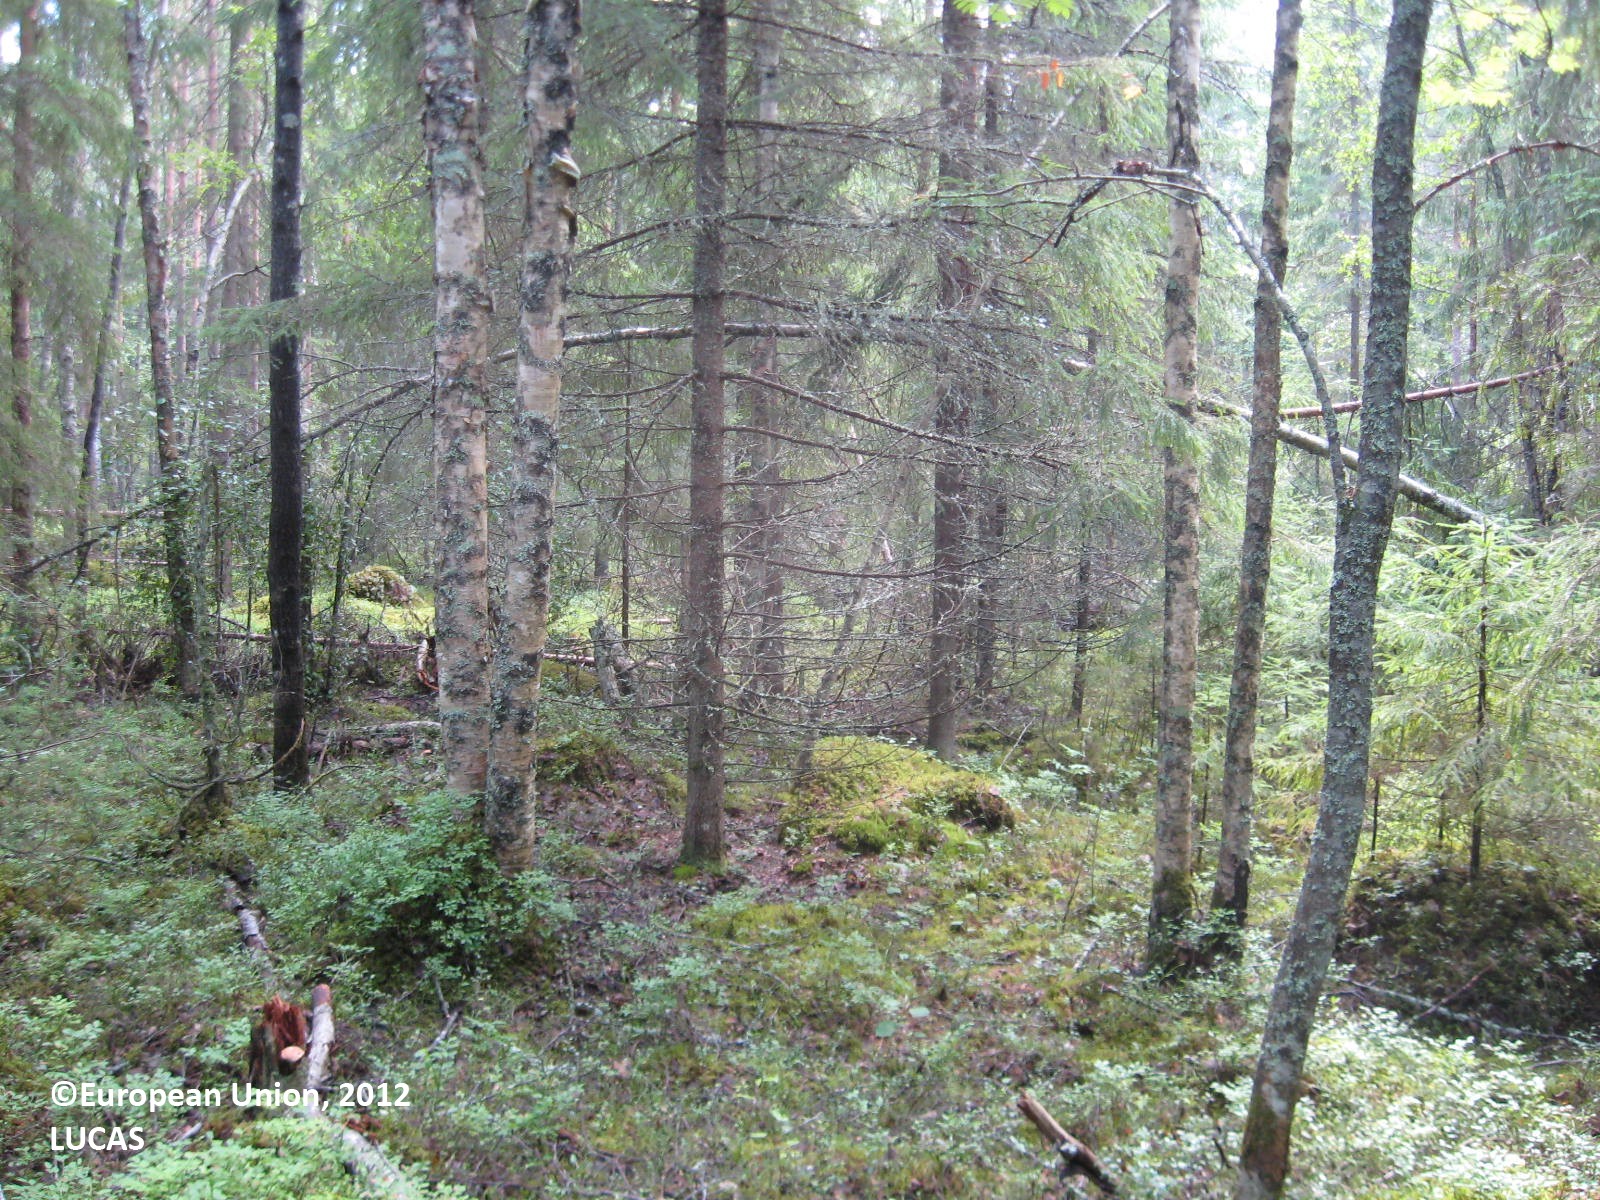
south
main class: Woodland
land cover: Other mixed woodland
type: boreal forest
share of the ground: > 75 %
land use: Forestry
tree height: > 5 m
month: July
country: FI
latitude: 62.0291
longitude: 22.7729
